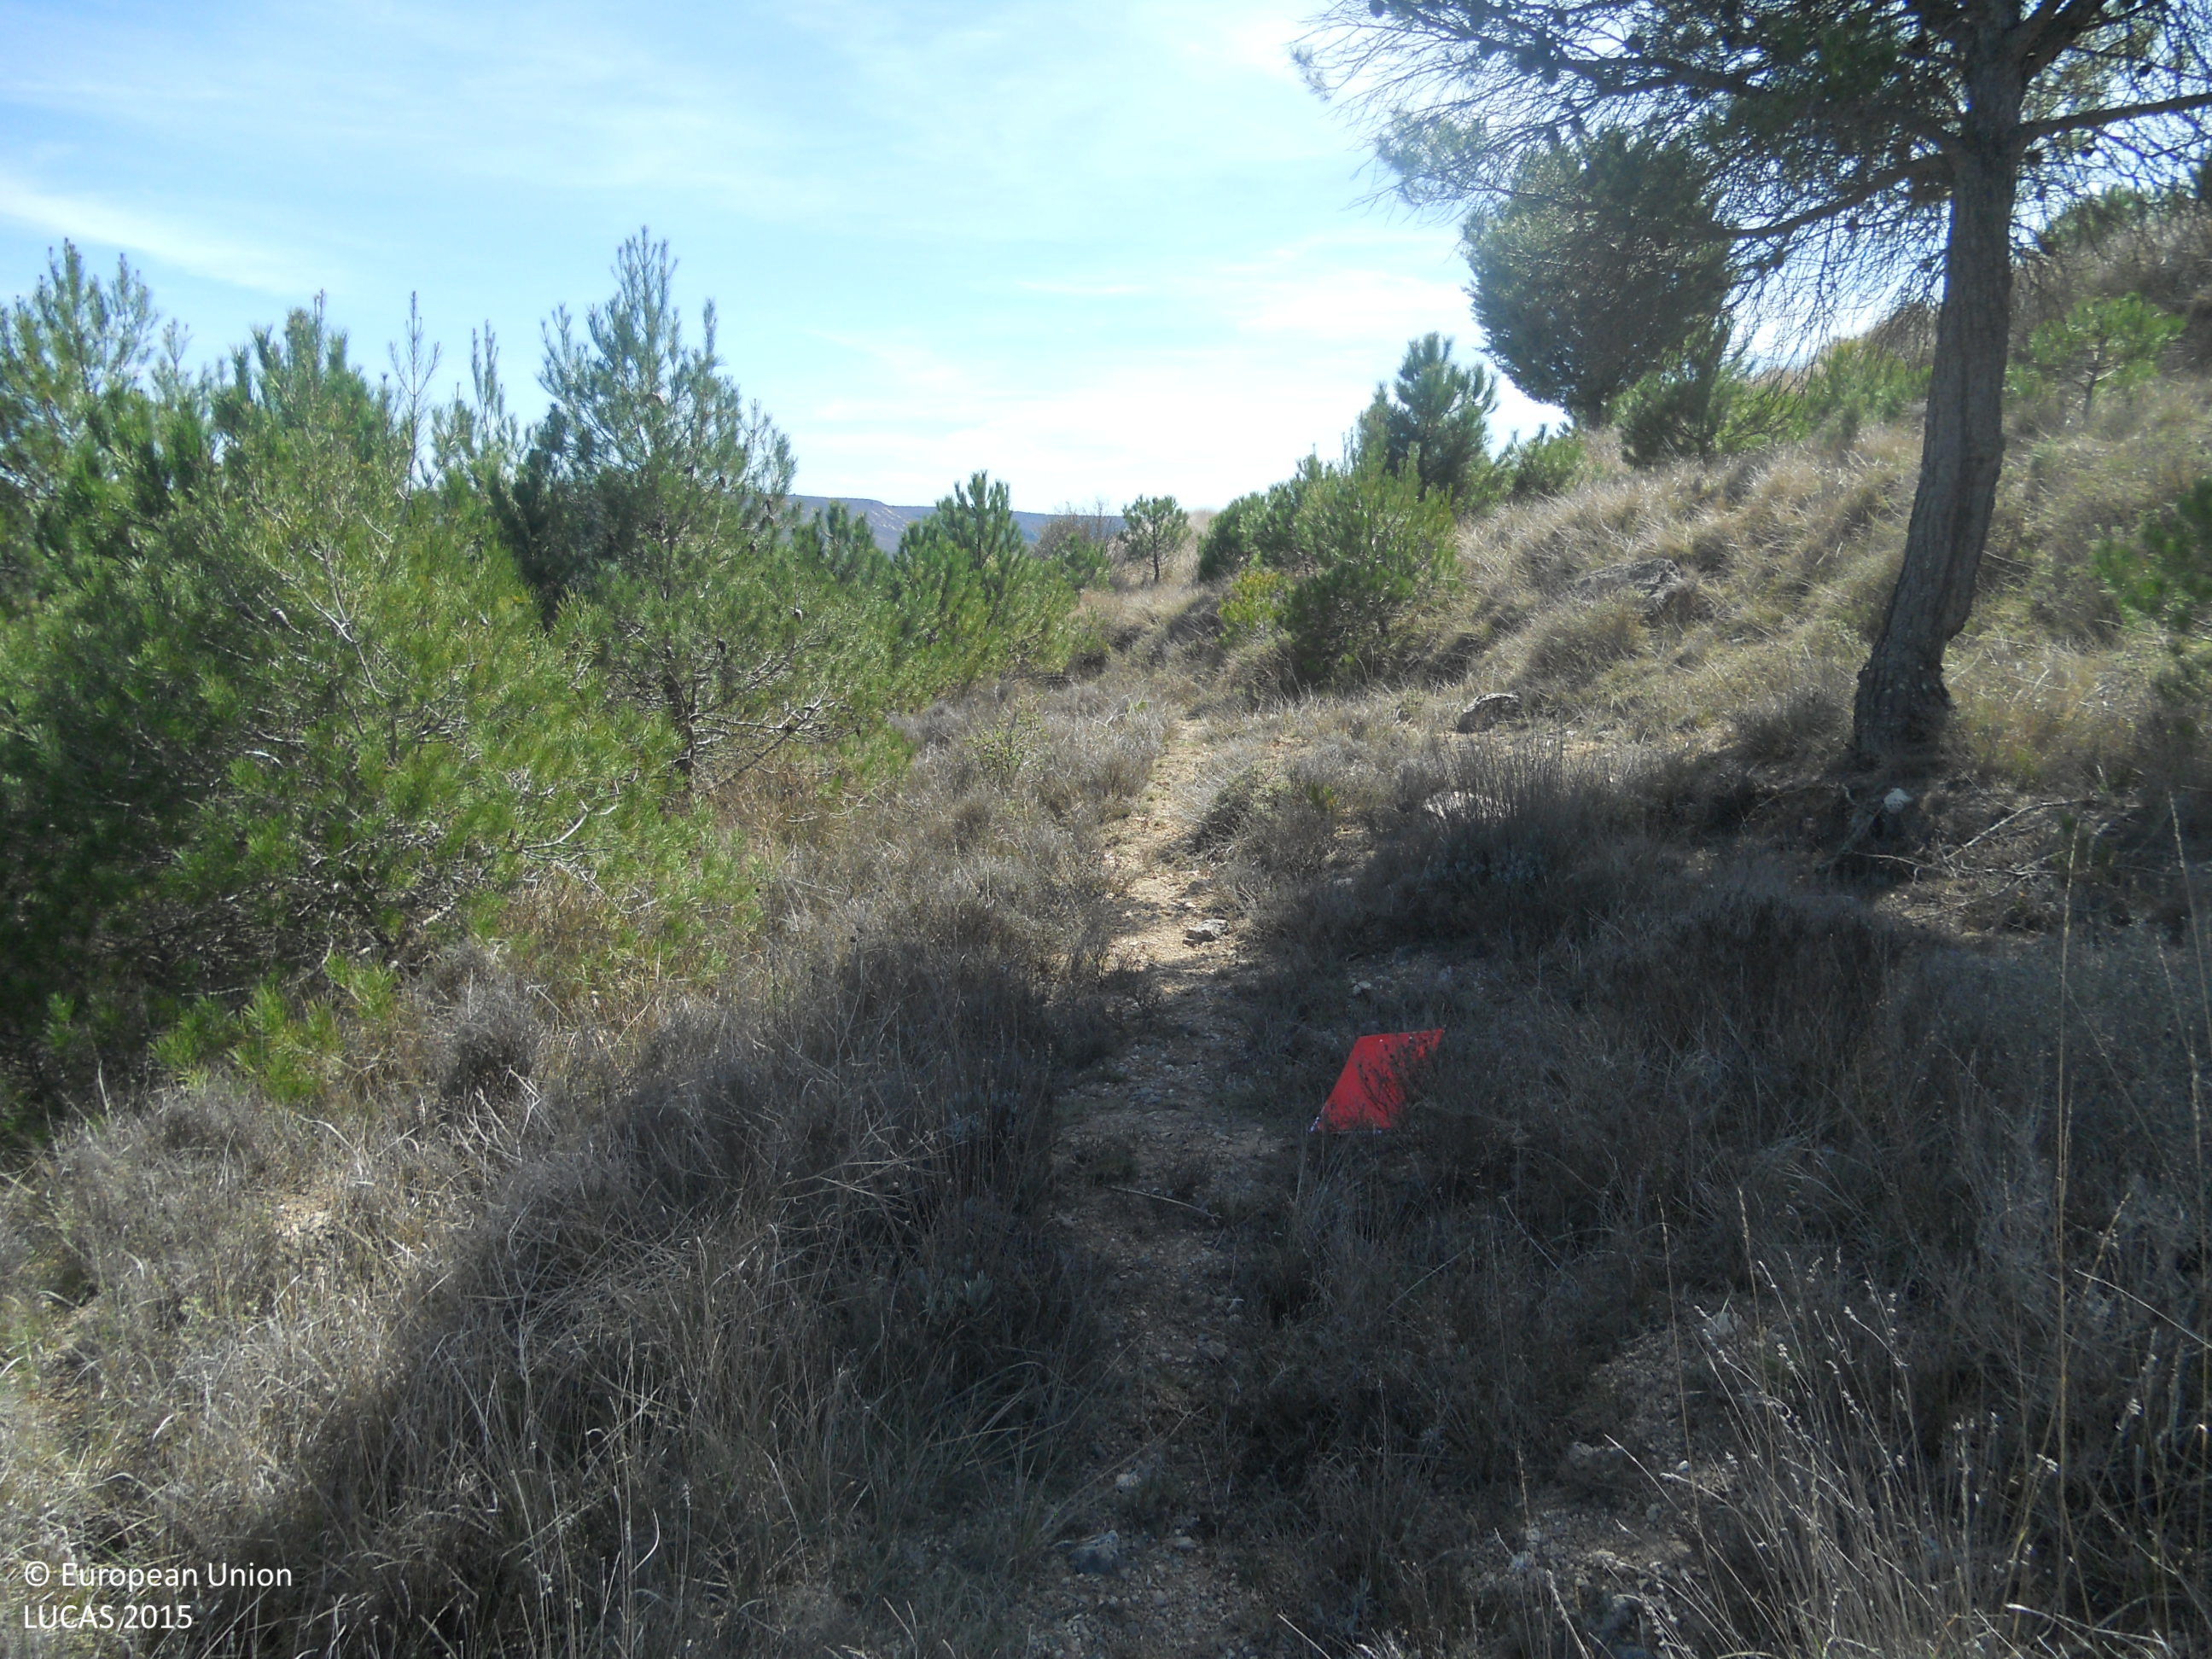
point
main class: Woodland
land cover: Pine dominated coniferous woodland
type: coniferous forest of the mediterranean region
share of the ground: 50 - 75 %
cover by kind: coniferous forest trees 65 %, herbaceous plants 20 %, shrubs 10 %, consolidated bare surface 5 %
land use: Forestry
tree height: > 5 m
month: April
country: ES
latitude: 42.1692
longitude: -4.2667
